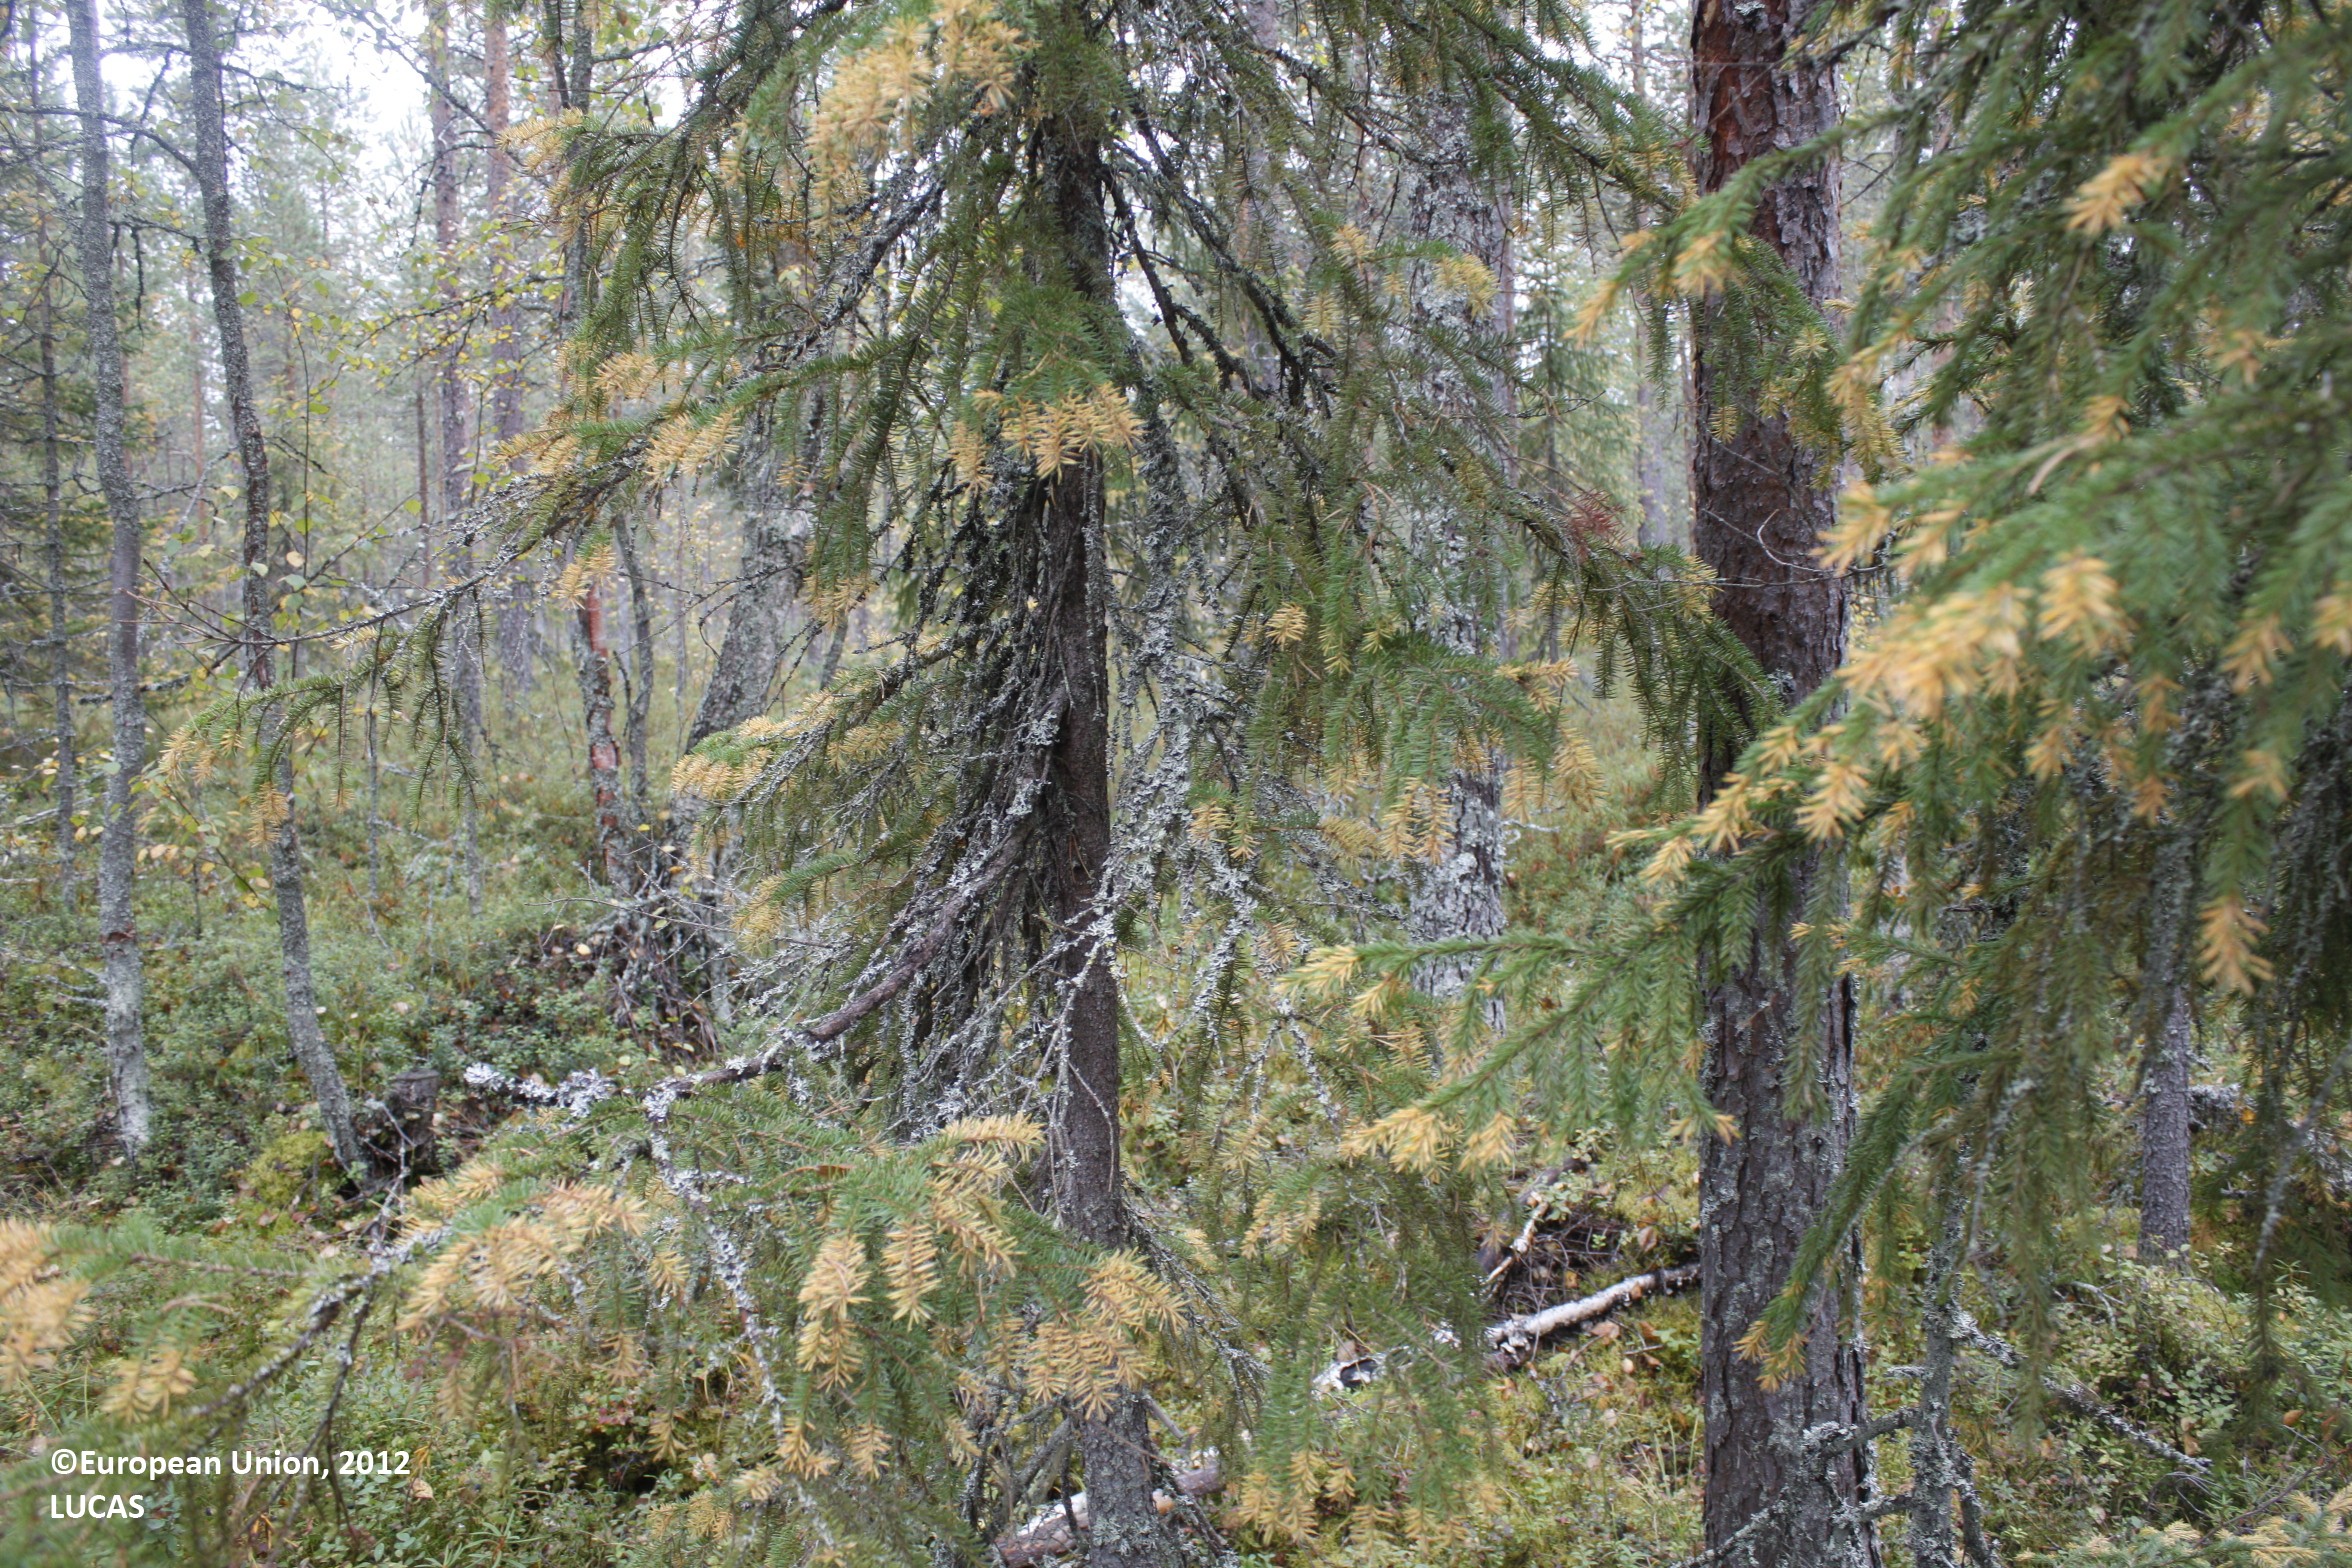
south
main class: Woodland
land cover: Pine dominated mixed woodland
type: boreal forest
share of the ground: 25 - 50 %
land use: Forestry
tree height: > 5 m
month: September
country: FI
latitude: 65.1269
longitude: 26.7984
